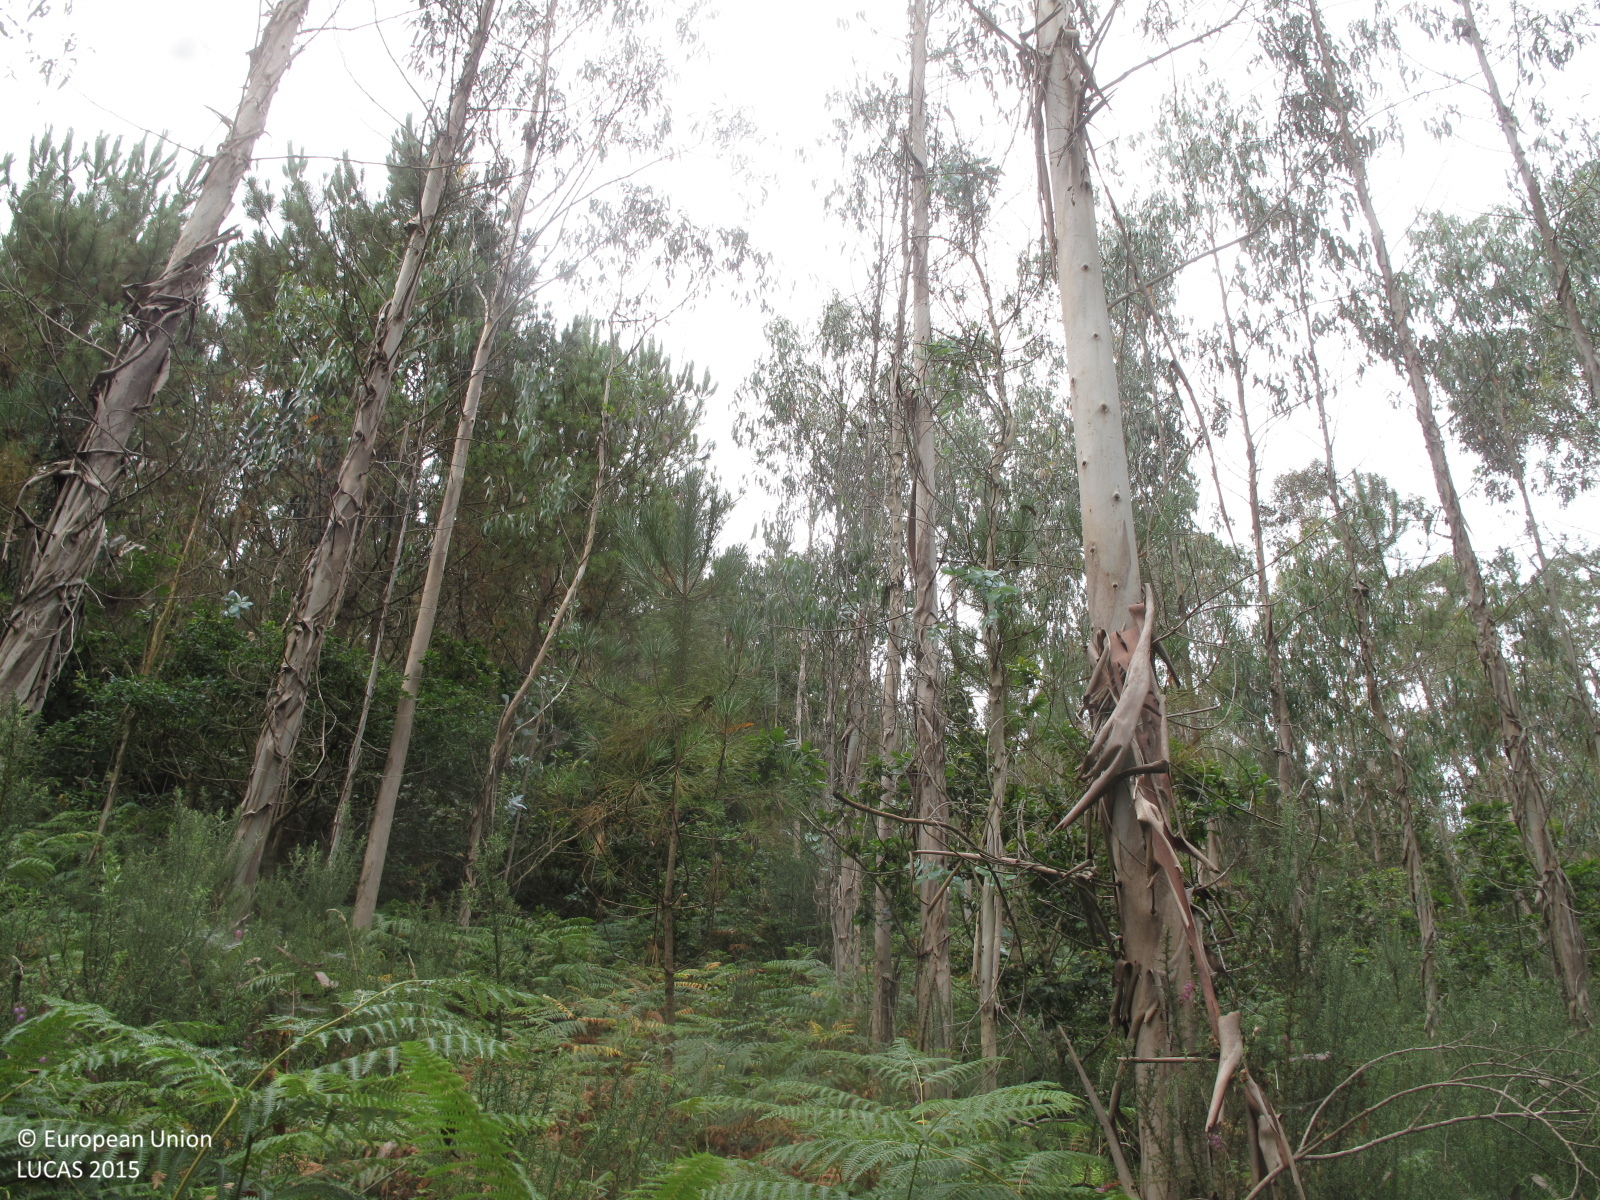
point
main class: Woodland
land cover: Broadleaved woodland
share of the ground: 25 - 50 %
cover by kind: herbaceous plants 50 %, broadleaved forest trees 40 %, shrubs 10 %
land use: Forestry
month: July
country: ES
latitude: 43.0554
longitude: -9.1959
